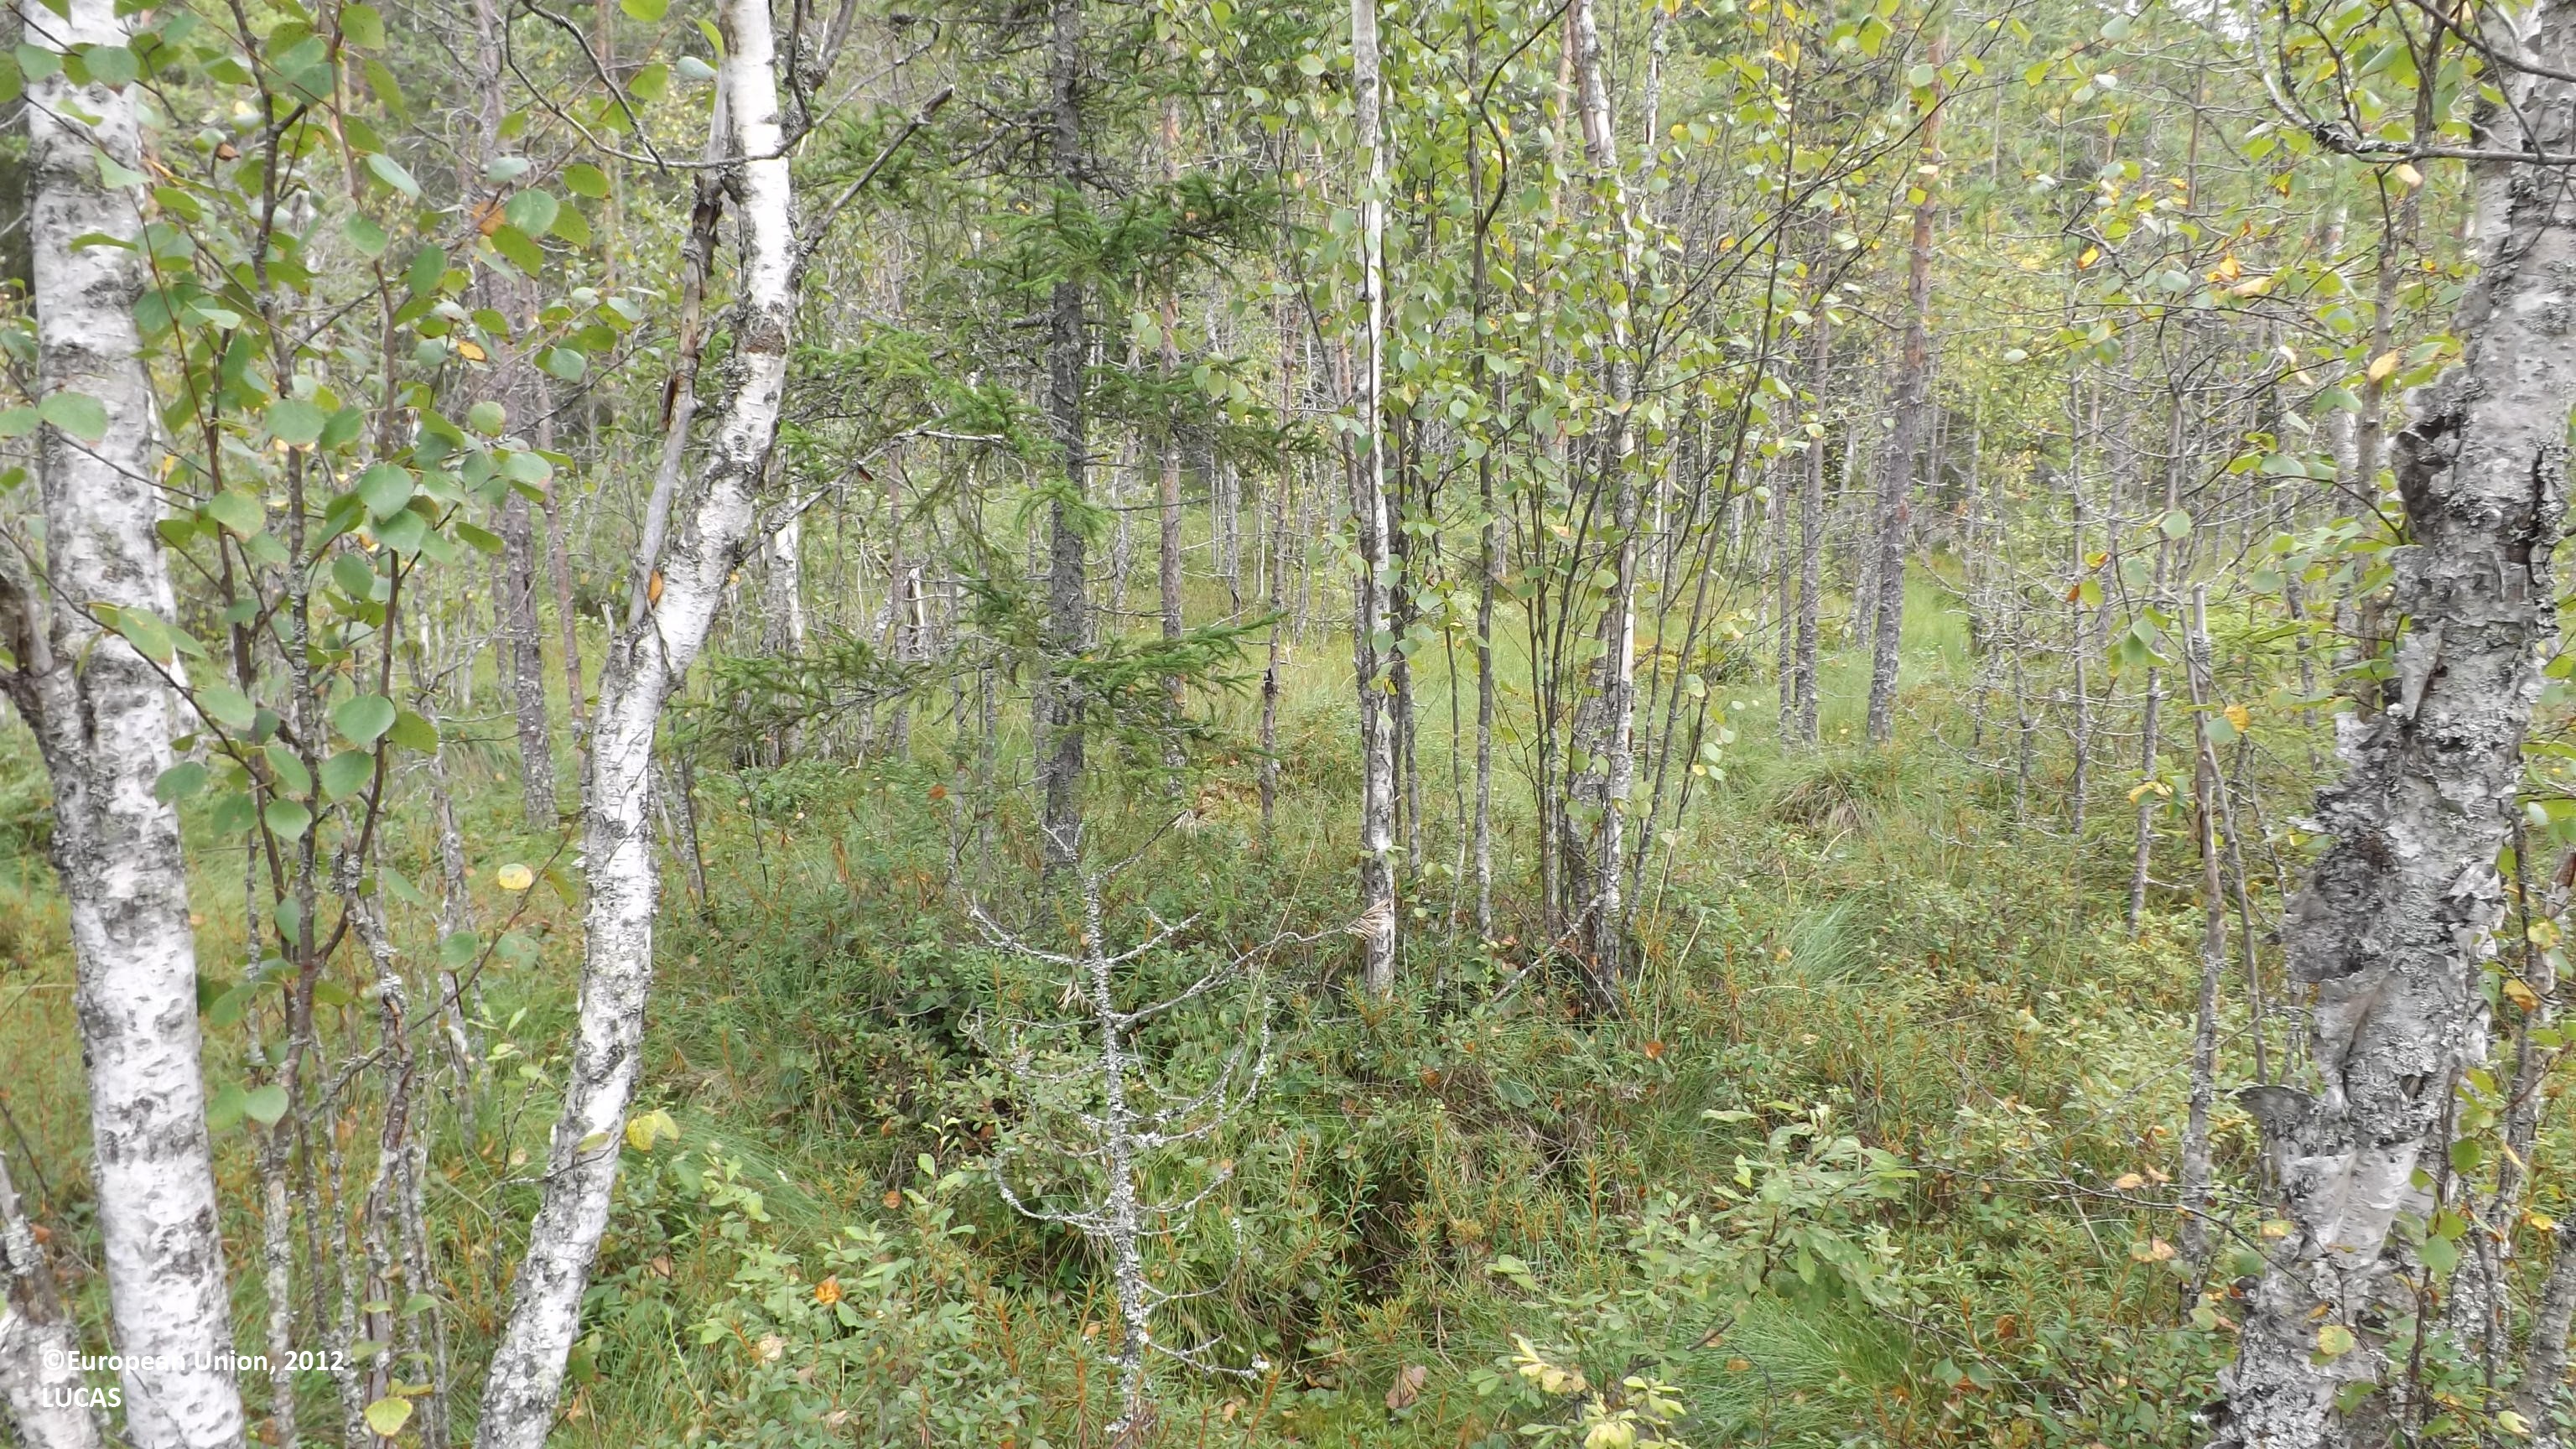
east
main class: Woodland
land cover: Pine dominated mixed woodland
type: mire and swamp forests
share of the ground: 25 - 50 %
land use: Semi-natural and natural areas not in use
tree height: > 5 m
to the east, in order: Pine dominated mixed woodland; Other mixed woodland; Spruce dominated mixed woodland; Spruce dominated coniferous woodland; Other mixed woodland
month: August
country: FI
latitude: 63.7030
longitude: 23.9669
